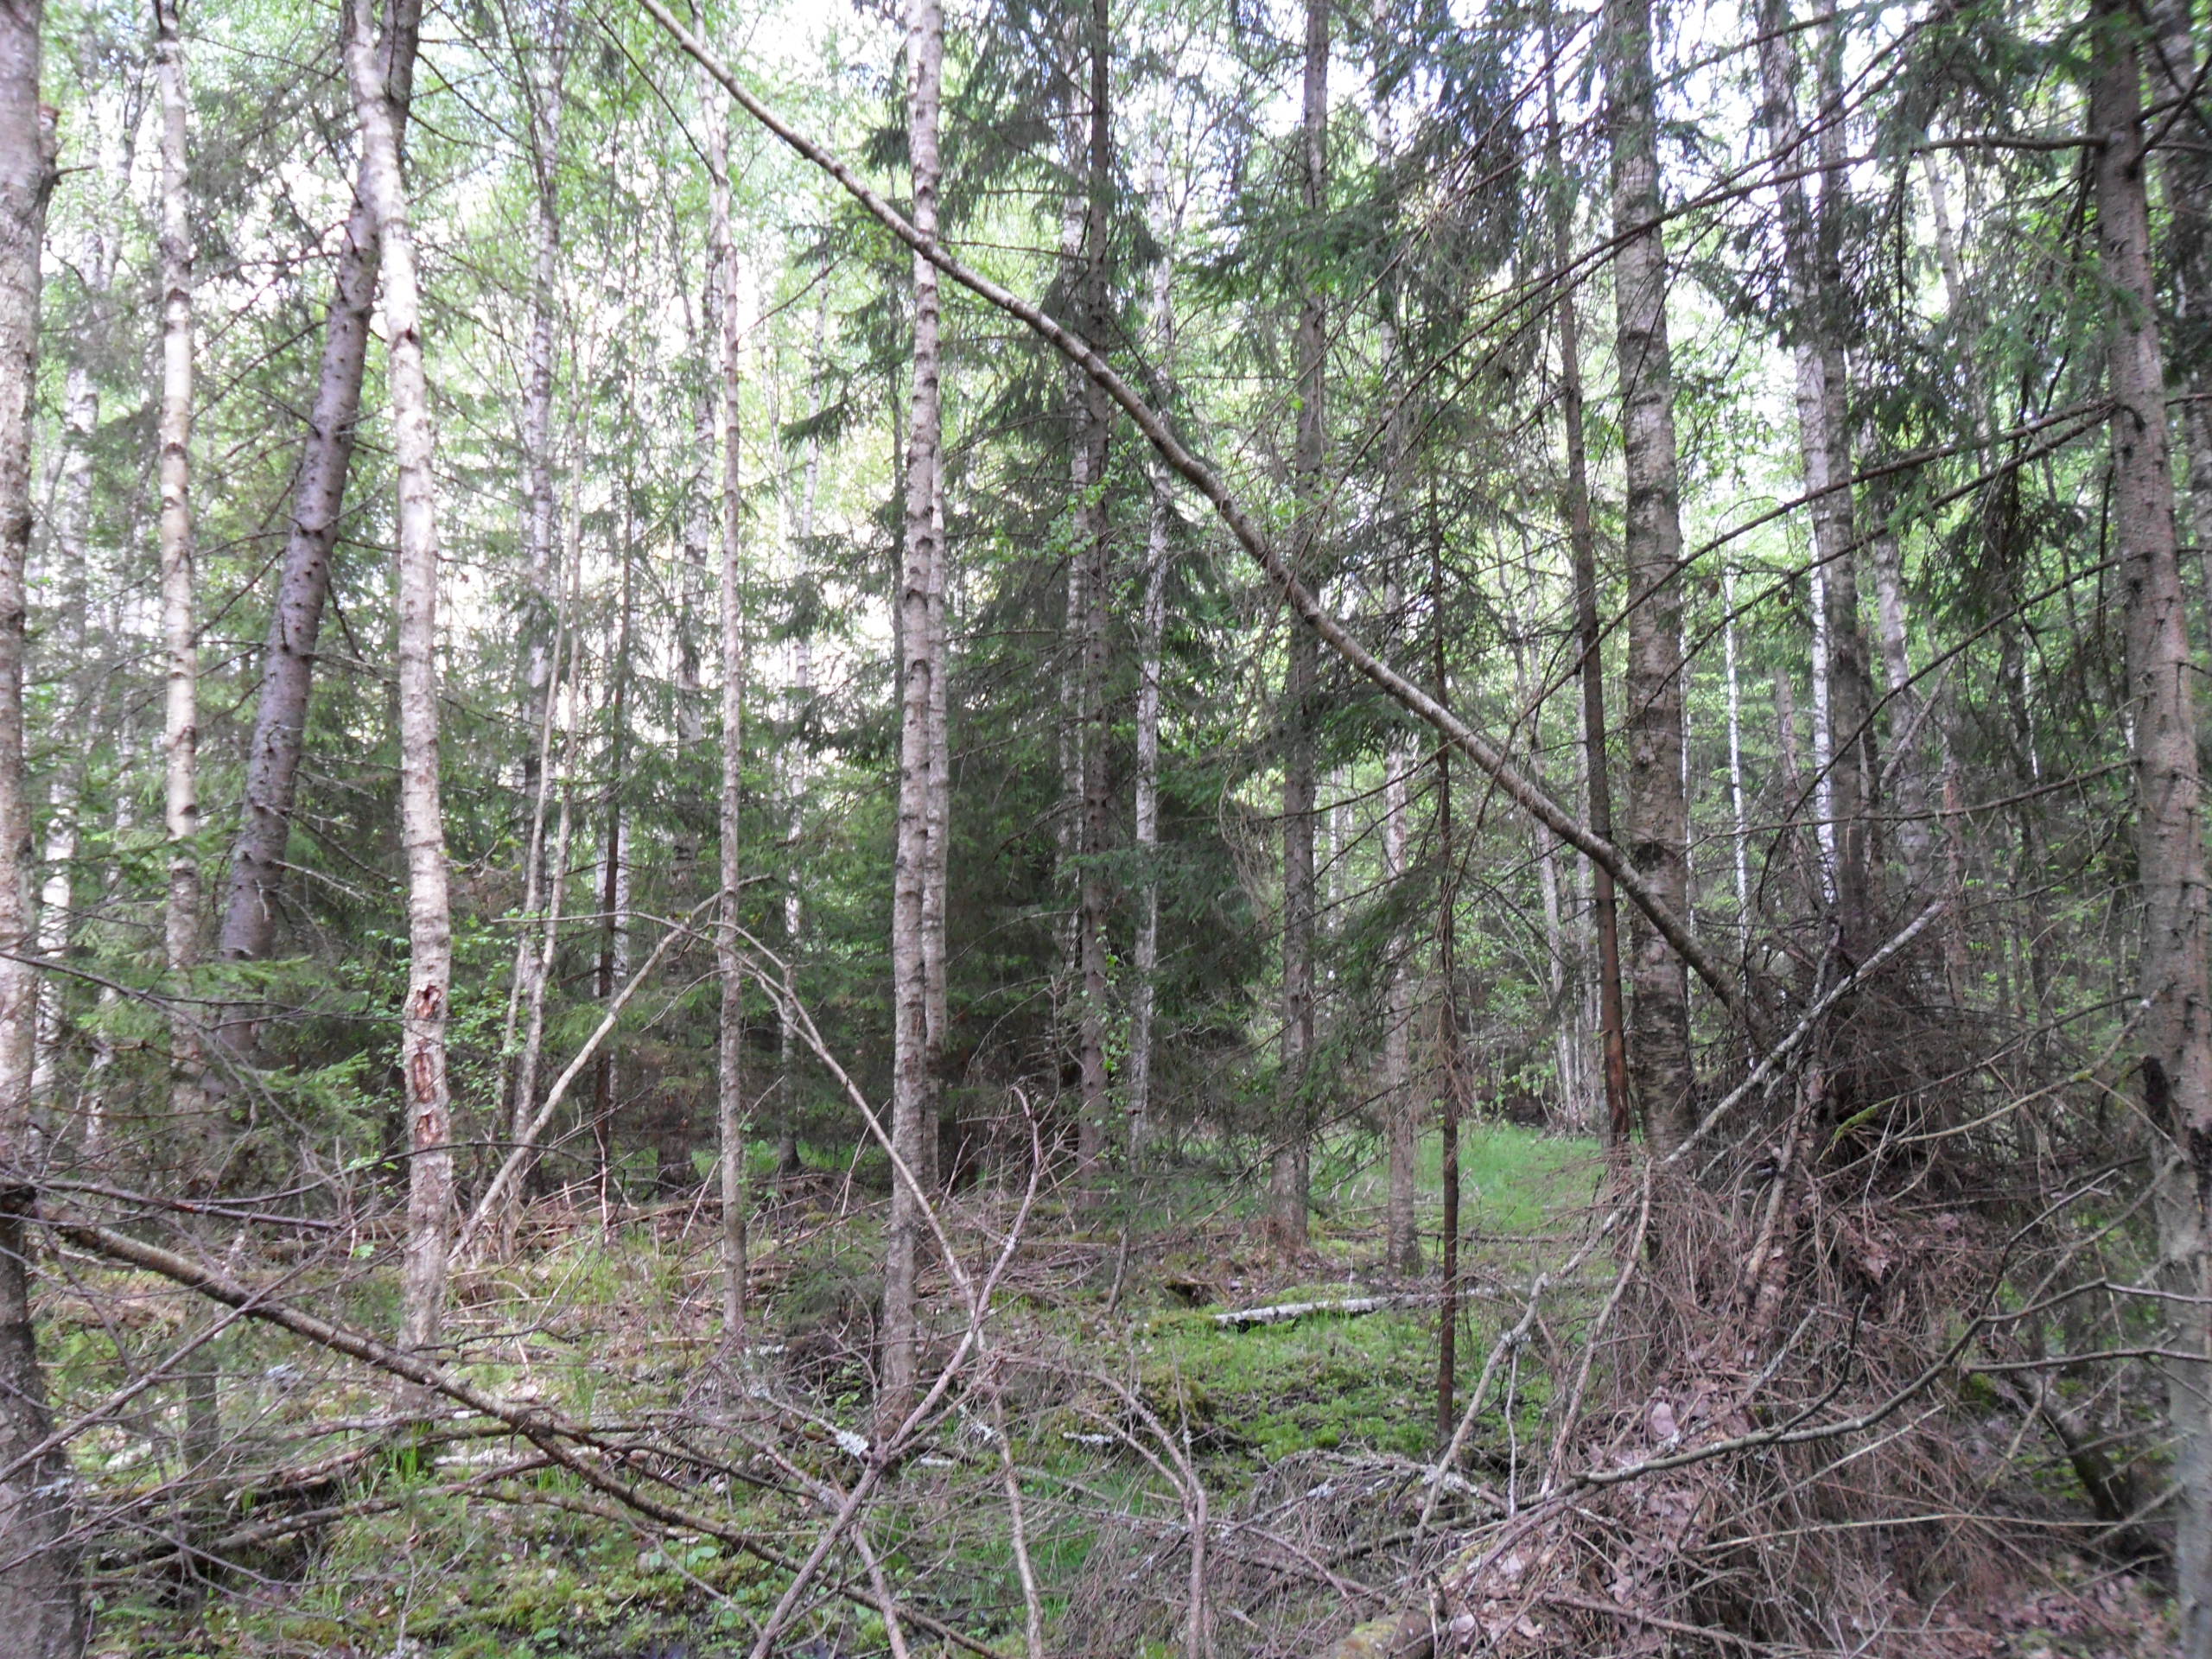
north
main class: Woodland
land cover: Spruce dominated mixed woodland
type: hemiboreal forest and nemoral coniferous forest and mixed broadleaved-coniferous forest
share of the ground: > 75 %
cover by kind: coniferous forest trees 60 %, broadleaved forest trees 40 %
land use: Forestry
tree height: > 5 m
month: May
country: LV
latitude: 57.2739
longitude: 22.4417
